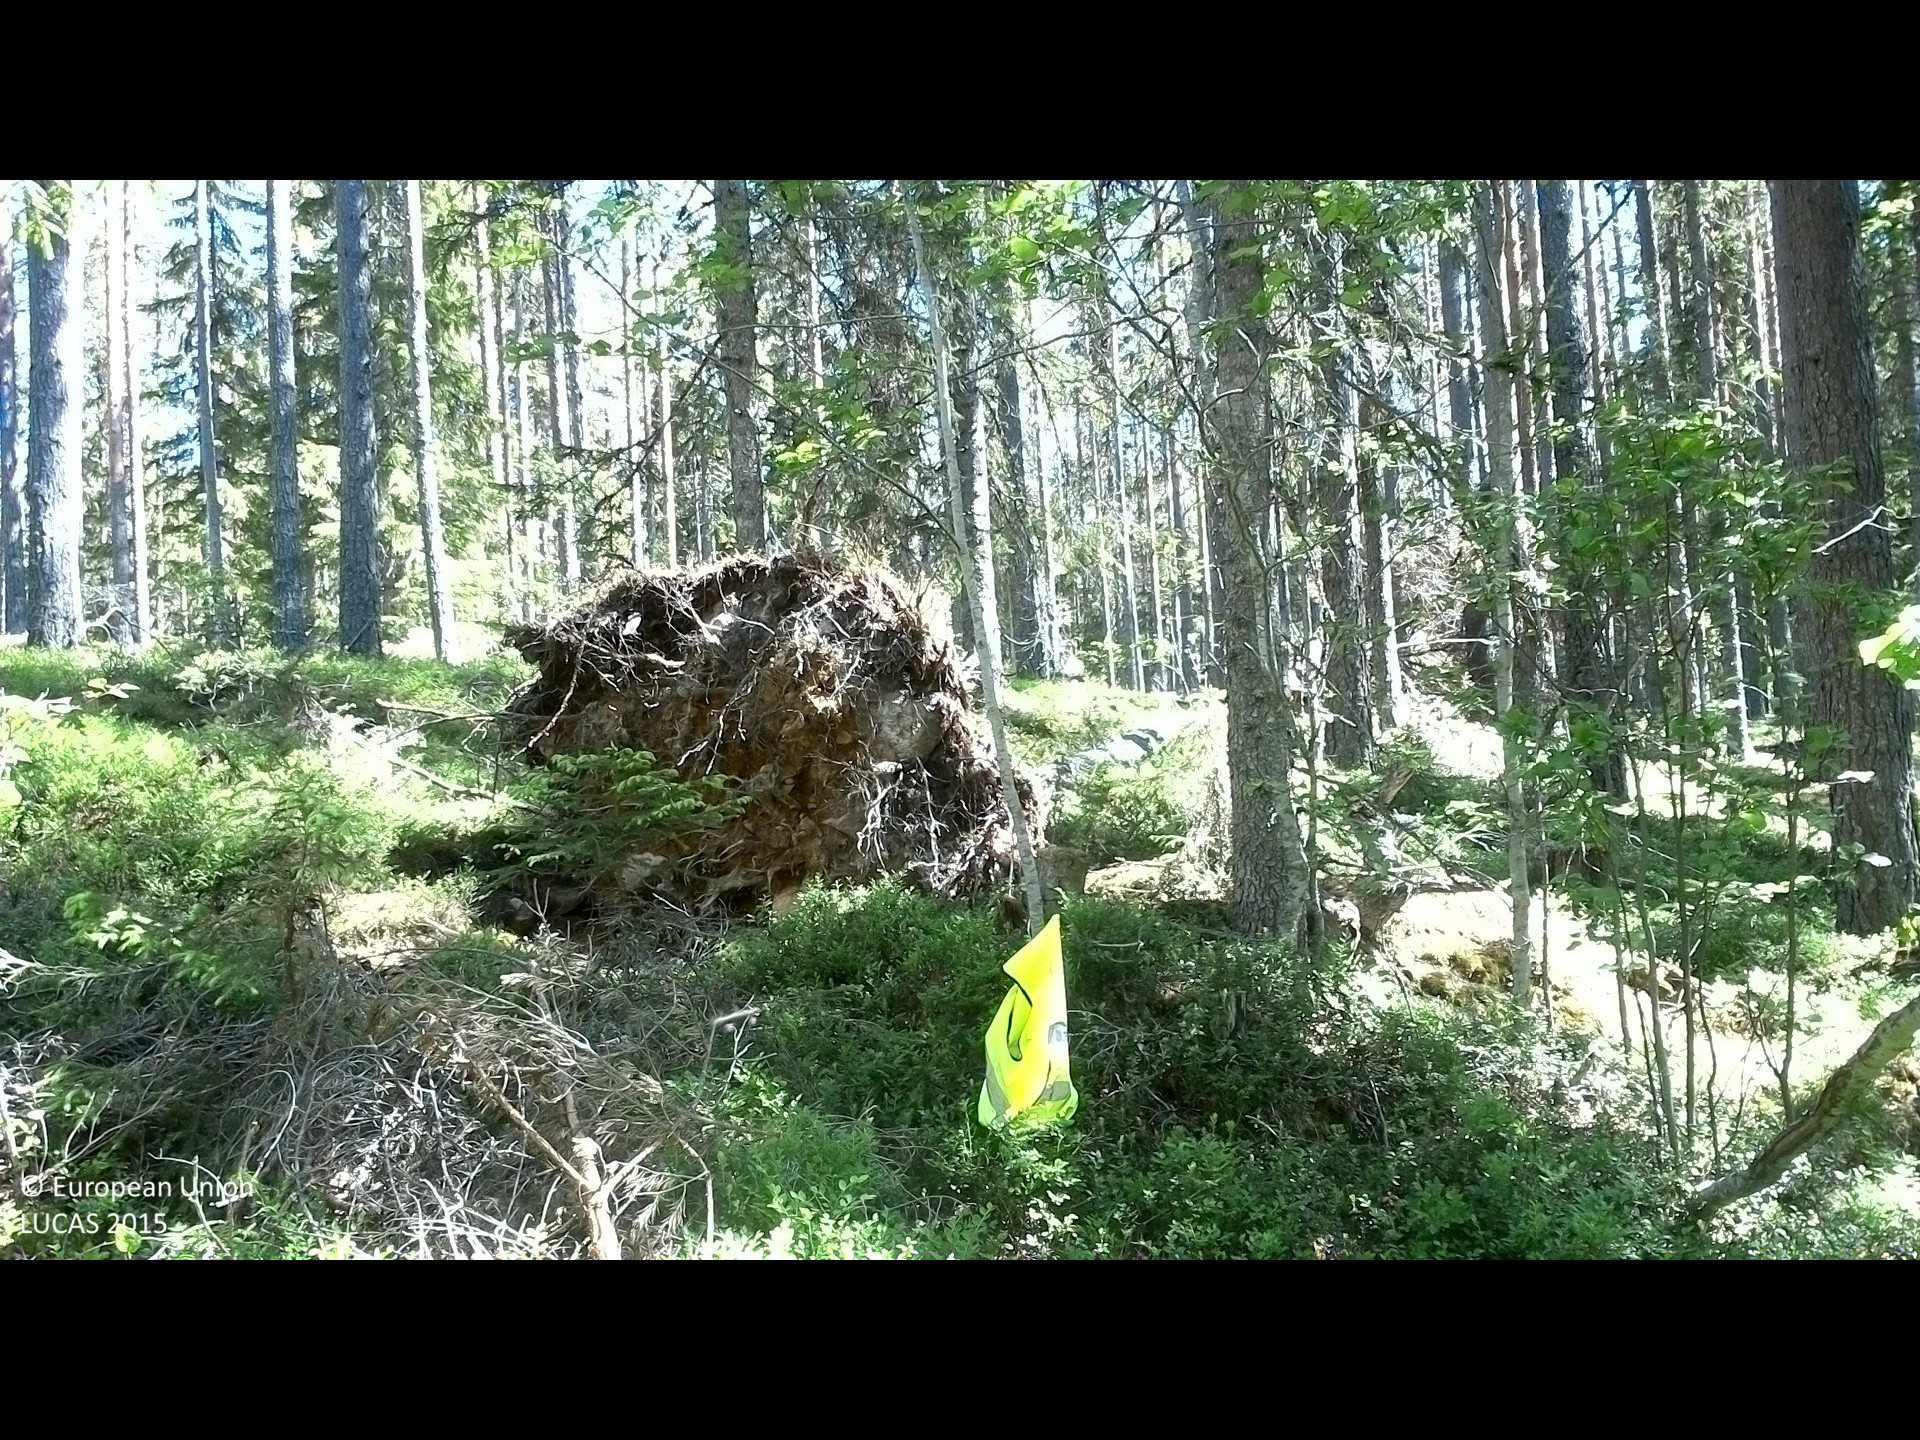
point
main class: Woodland
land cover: Pine dominated coniferous woodland
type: boreal forest
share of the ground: 25 - 50 %
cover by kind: coniferous forest trees 45 %, shrubs 40 %, lichens and mosses 10 %, broadleaved forest trees 5 %
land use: Forestry
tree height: > 5 m
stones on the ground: 10 - 25 %
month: June
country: SE
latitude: 62.0523
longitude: 16.1592
